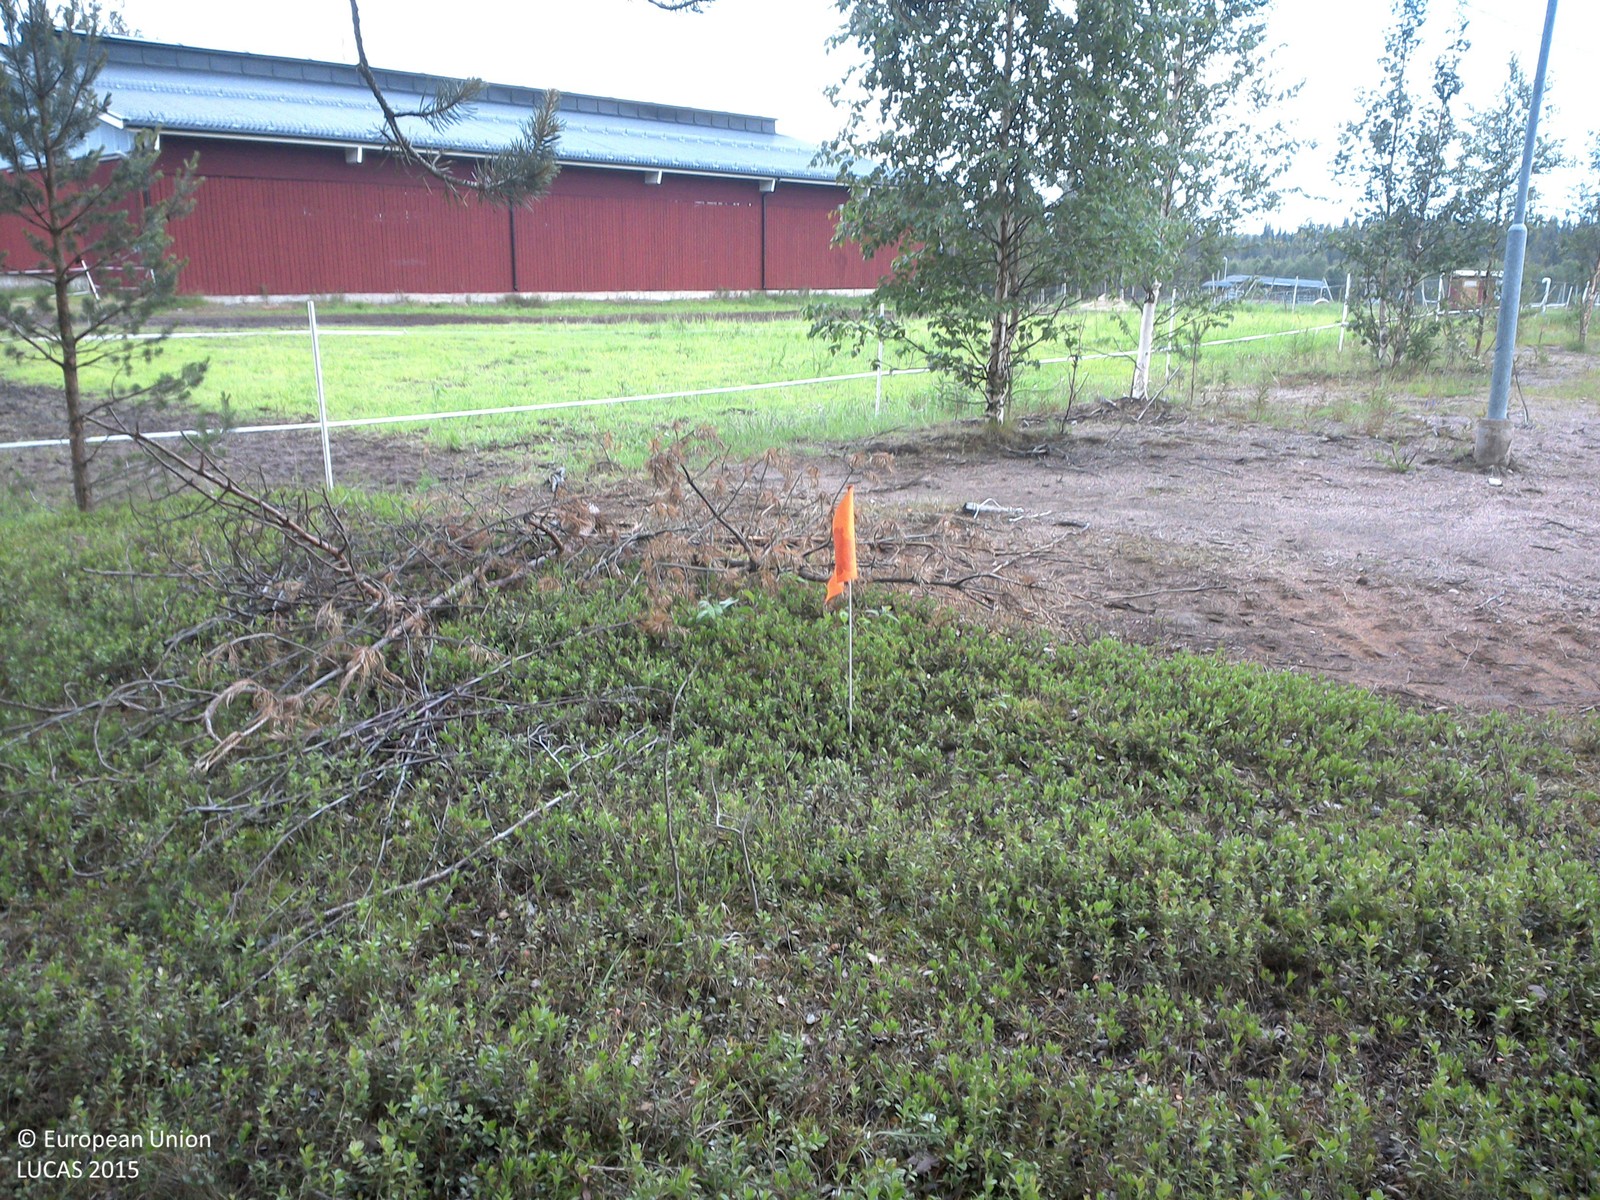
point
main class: Woodland
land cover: Pine dominated coniferous woodland
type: boreal forest
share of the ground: 25 - 50 %
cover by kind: shrubs 55 %, coniferous forest trees 45 %
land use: Forestry
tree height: > 5 m
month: July
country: SE
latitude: 66.9790
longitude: 23.7989
